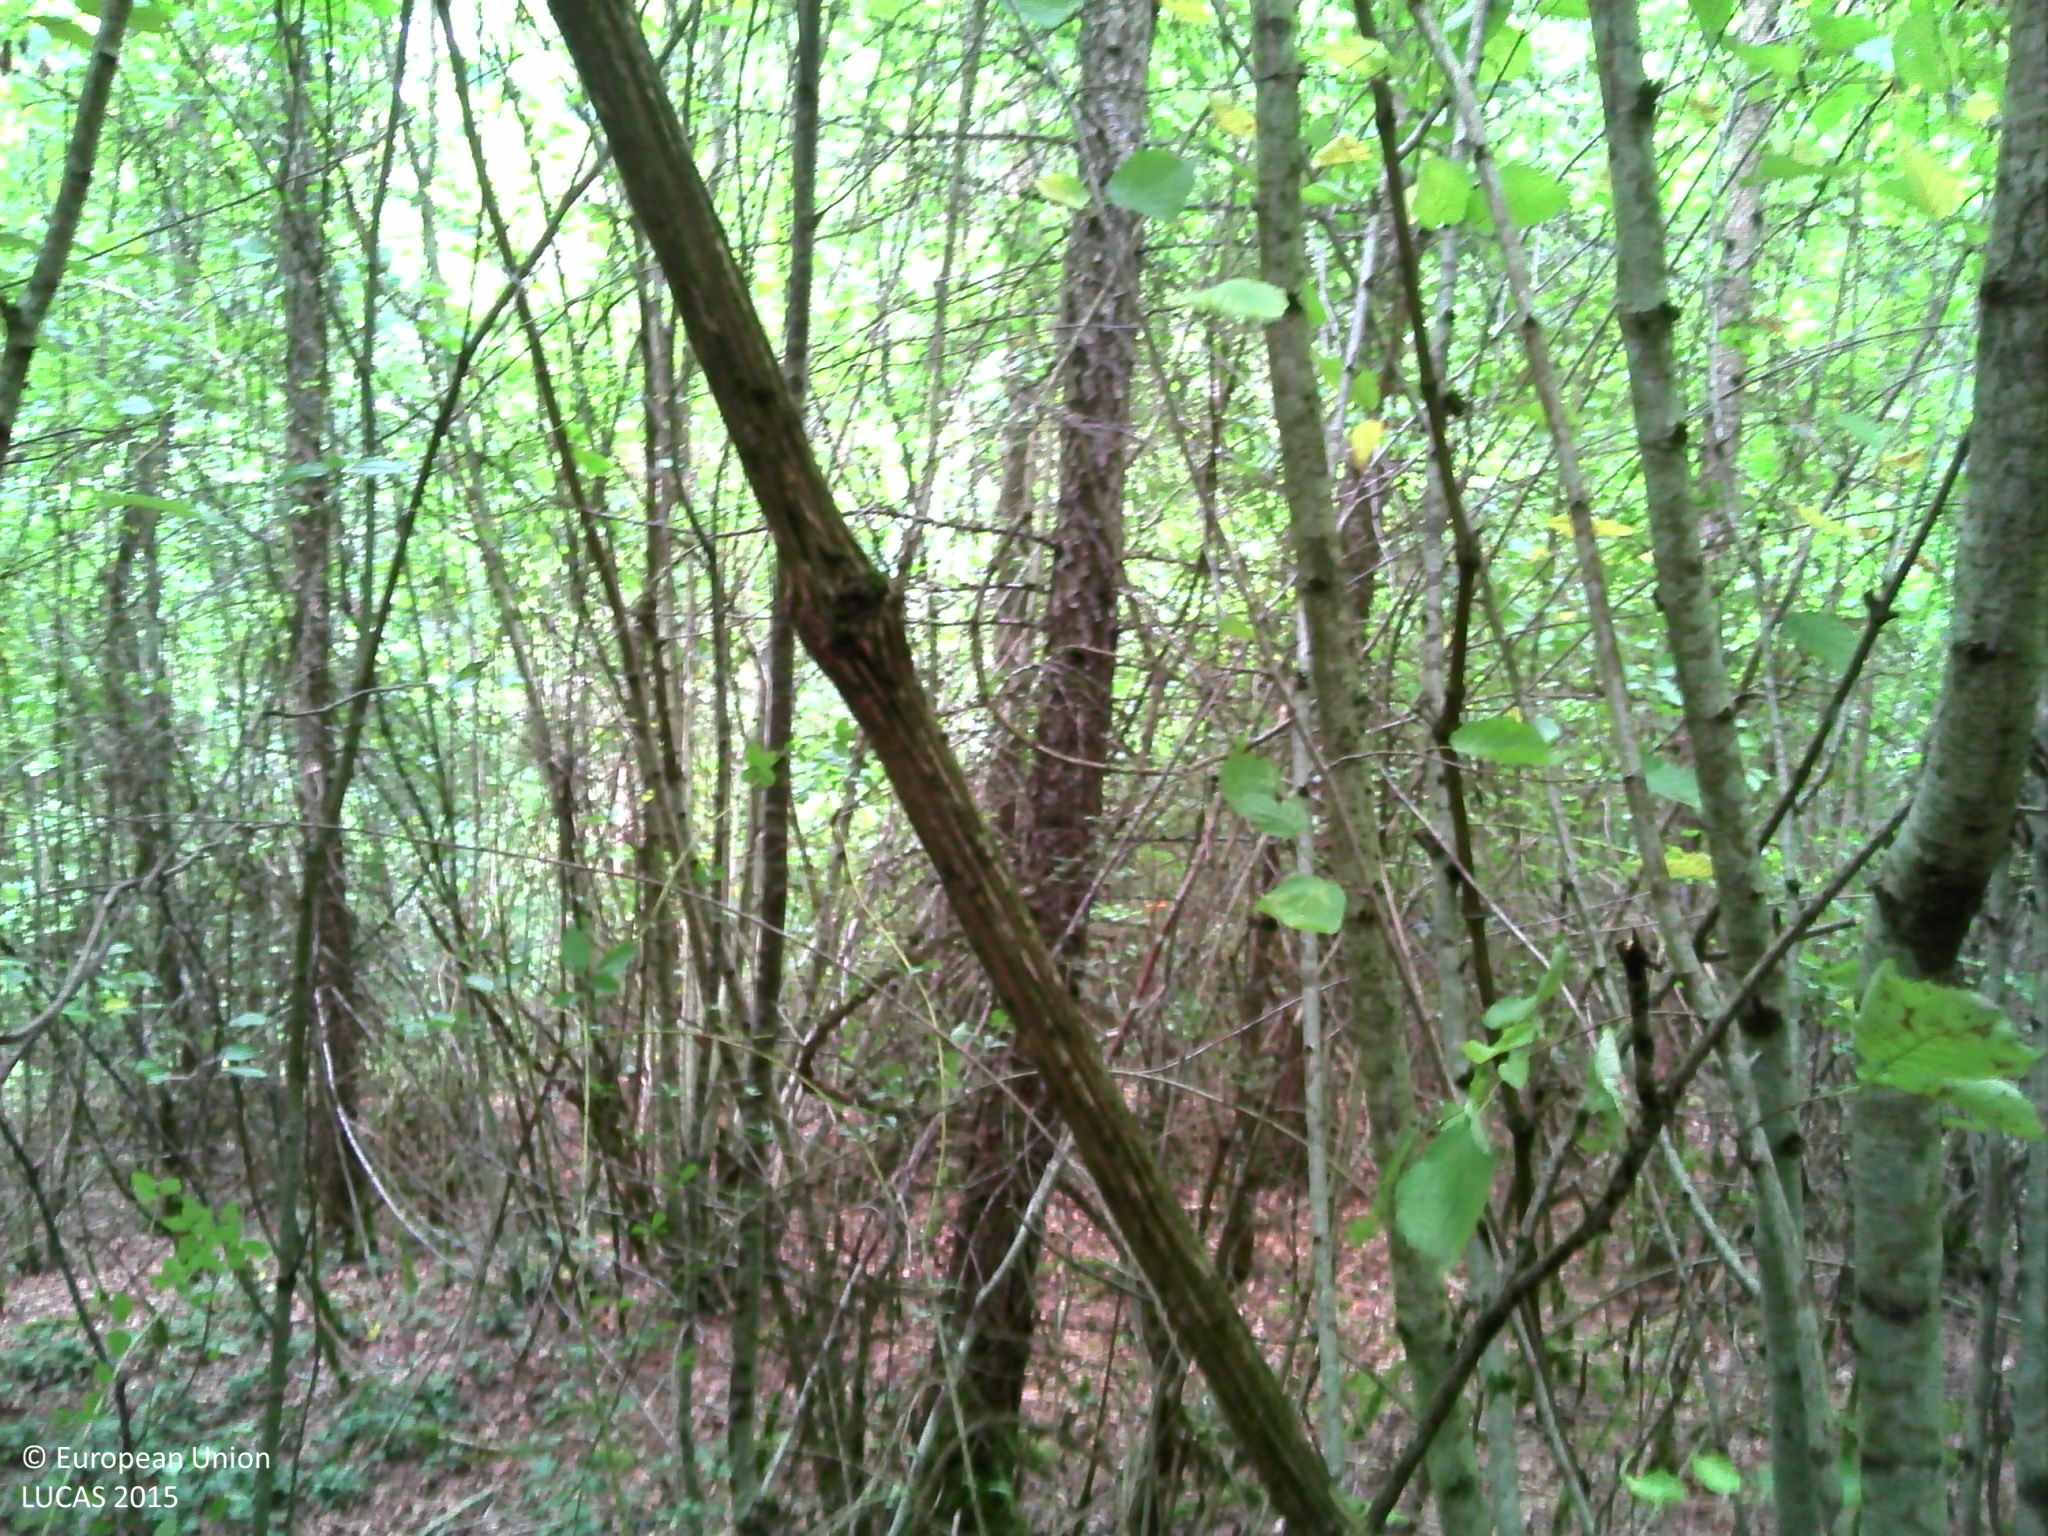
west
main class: Woodland
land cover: Other mixed woodland
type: exotic forest
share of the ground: > 75 %
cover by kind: coniferous forest trees 50 %, broadleaved forest trees 40 %, herbaceous plants 5 %, lichens and mosses 5 %
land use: Forestry
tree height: > 5 m
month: August
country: FR
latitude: 47.6919
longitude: 4.9232
